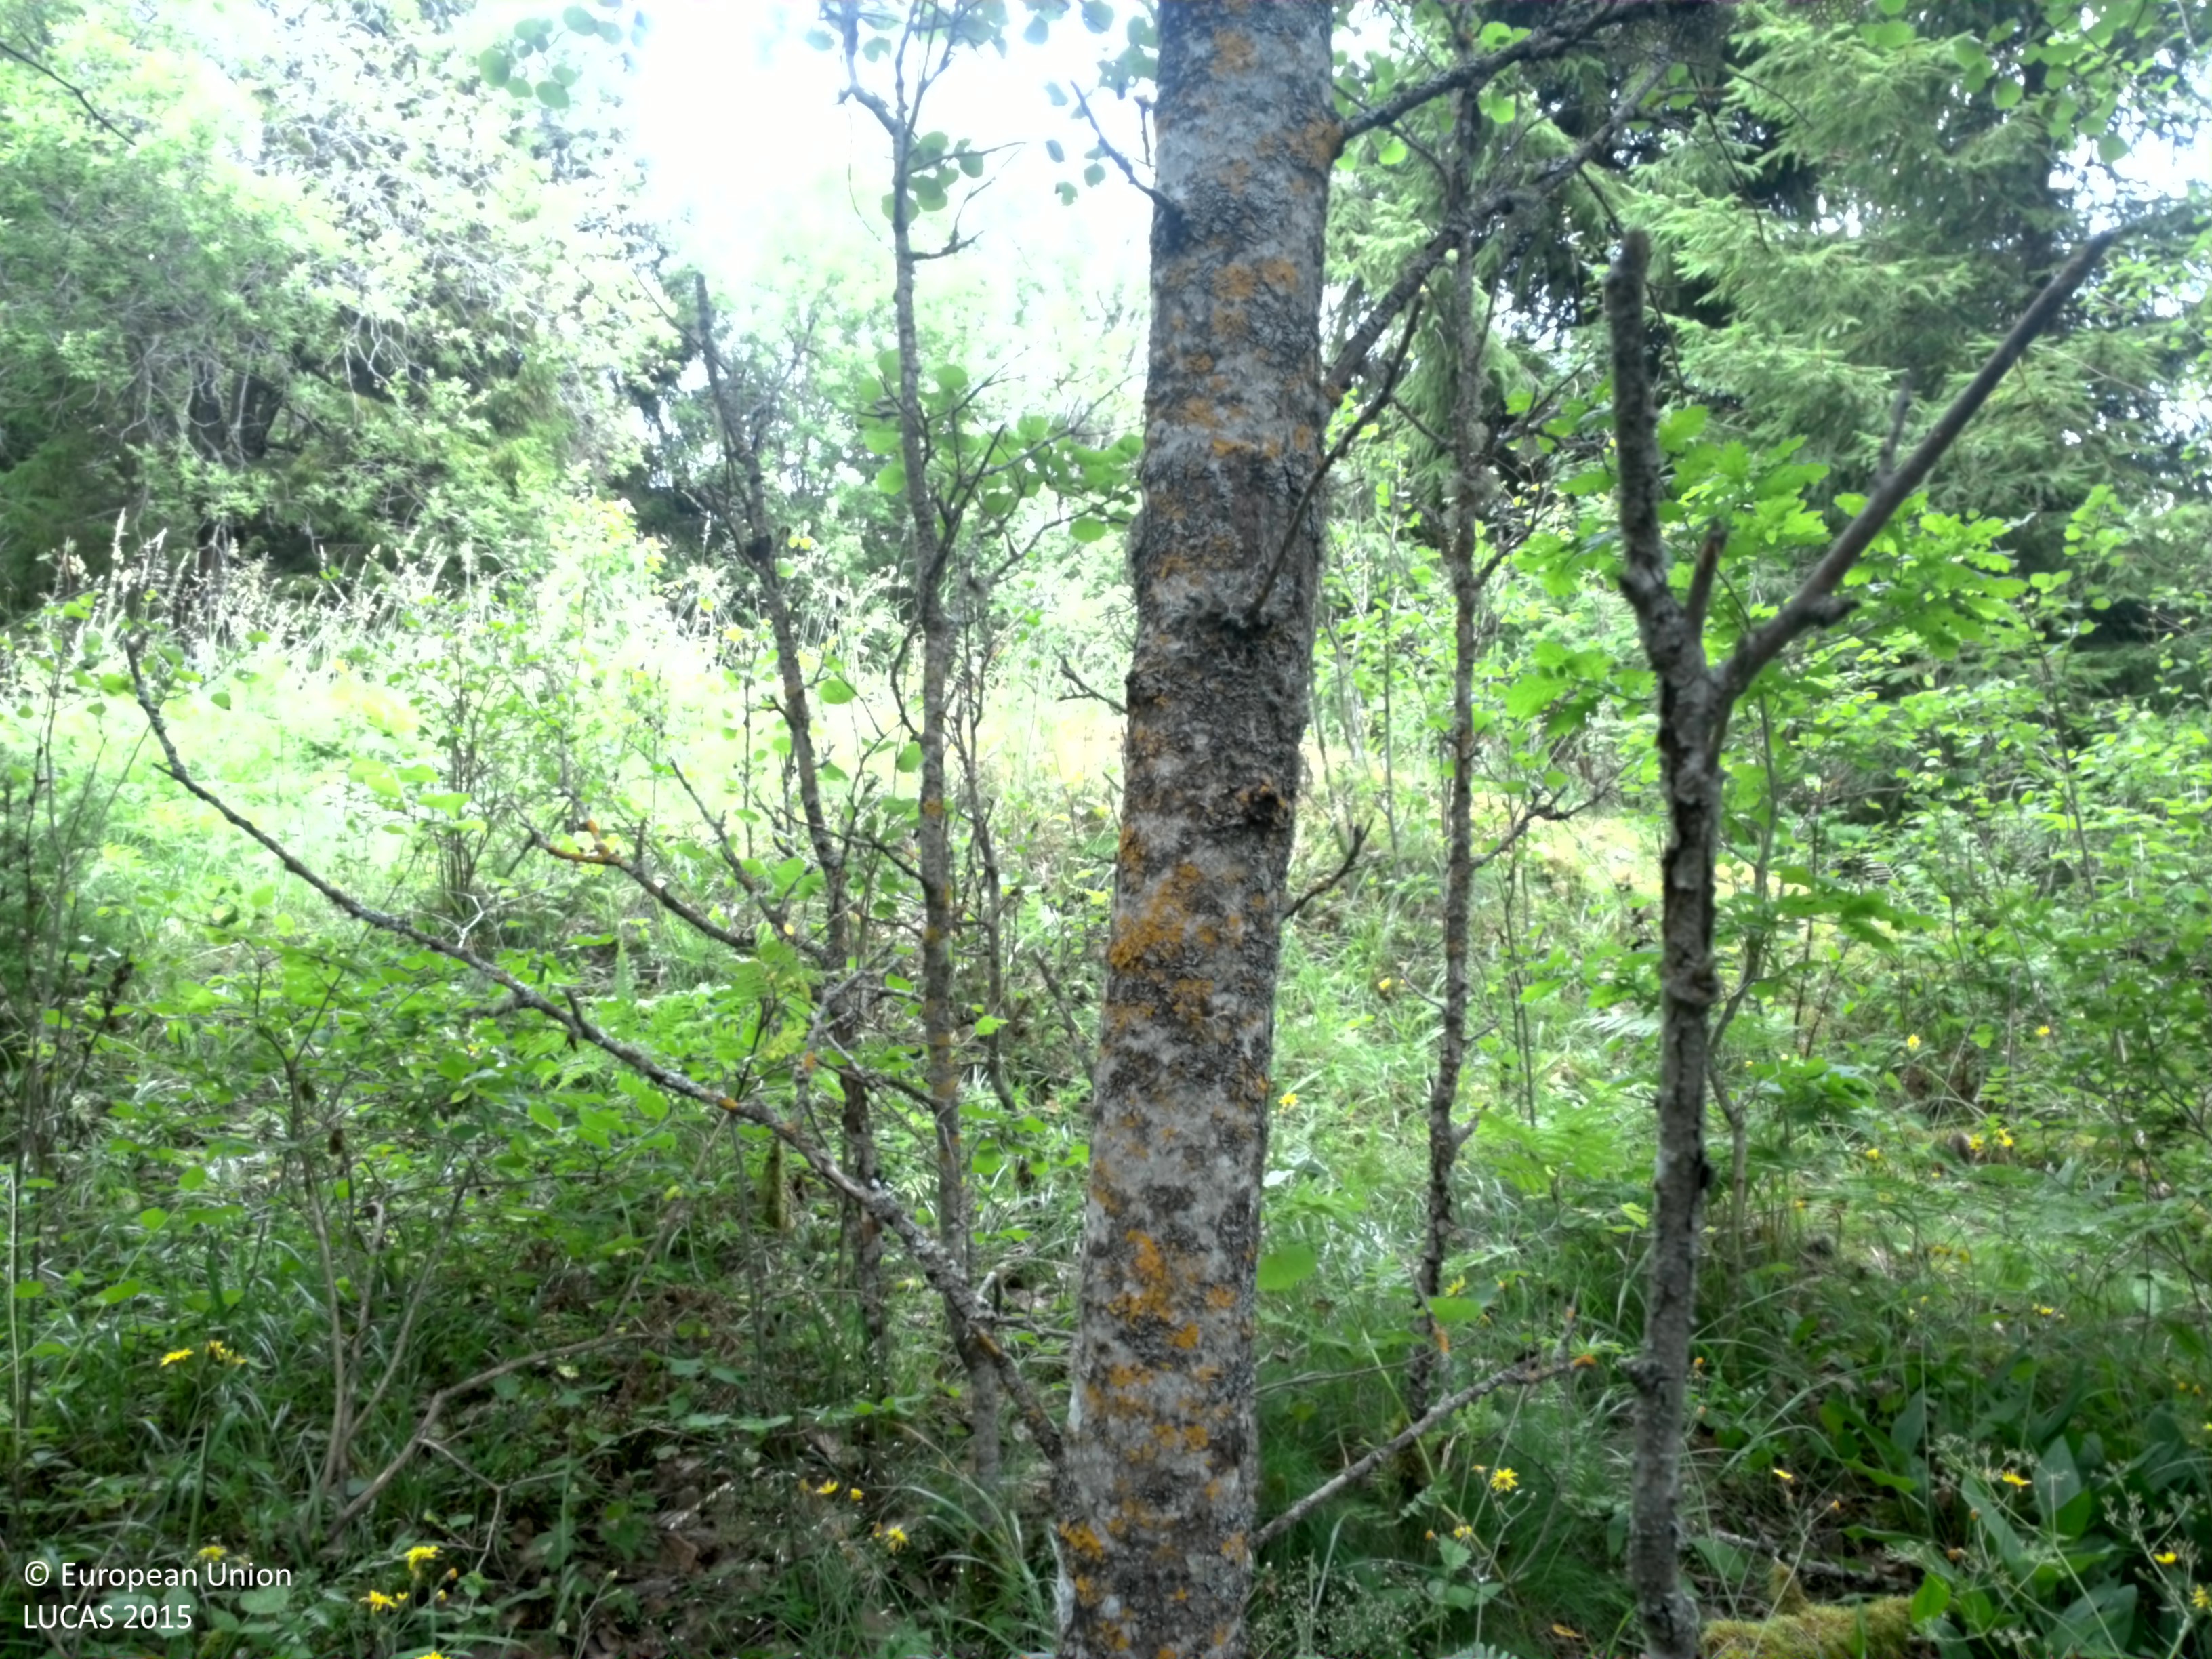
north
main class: Woodland
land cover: Broadleaved woodland
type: boreal forest
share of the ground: > 75 %
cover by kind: broadleaved forest trees 65 %, coniferous forest trees 20 %, herbaceous plants 15 %
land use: Forestry
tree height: > 5 m
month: July
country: SE
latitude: 59.7645
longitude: 17.4896
